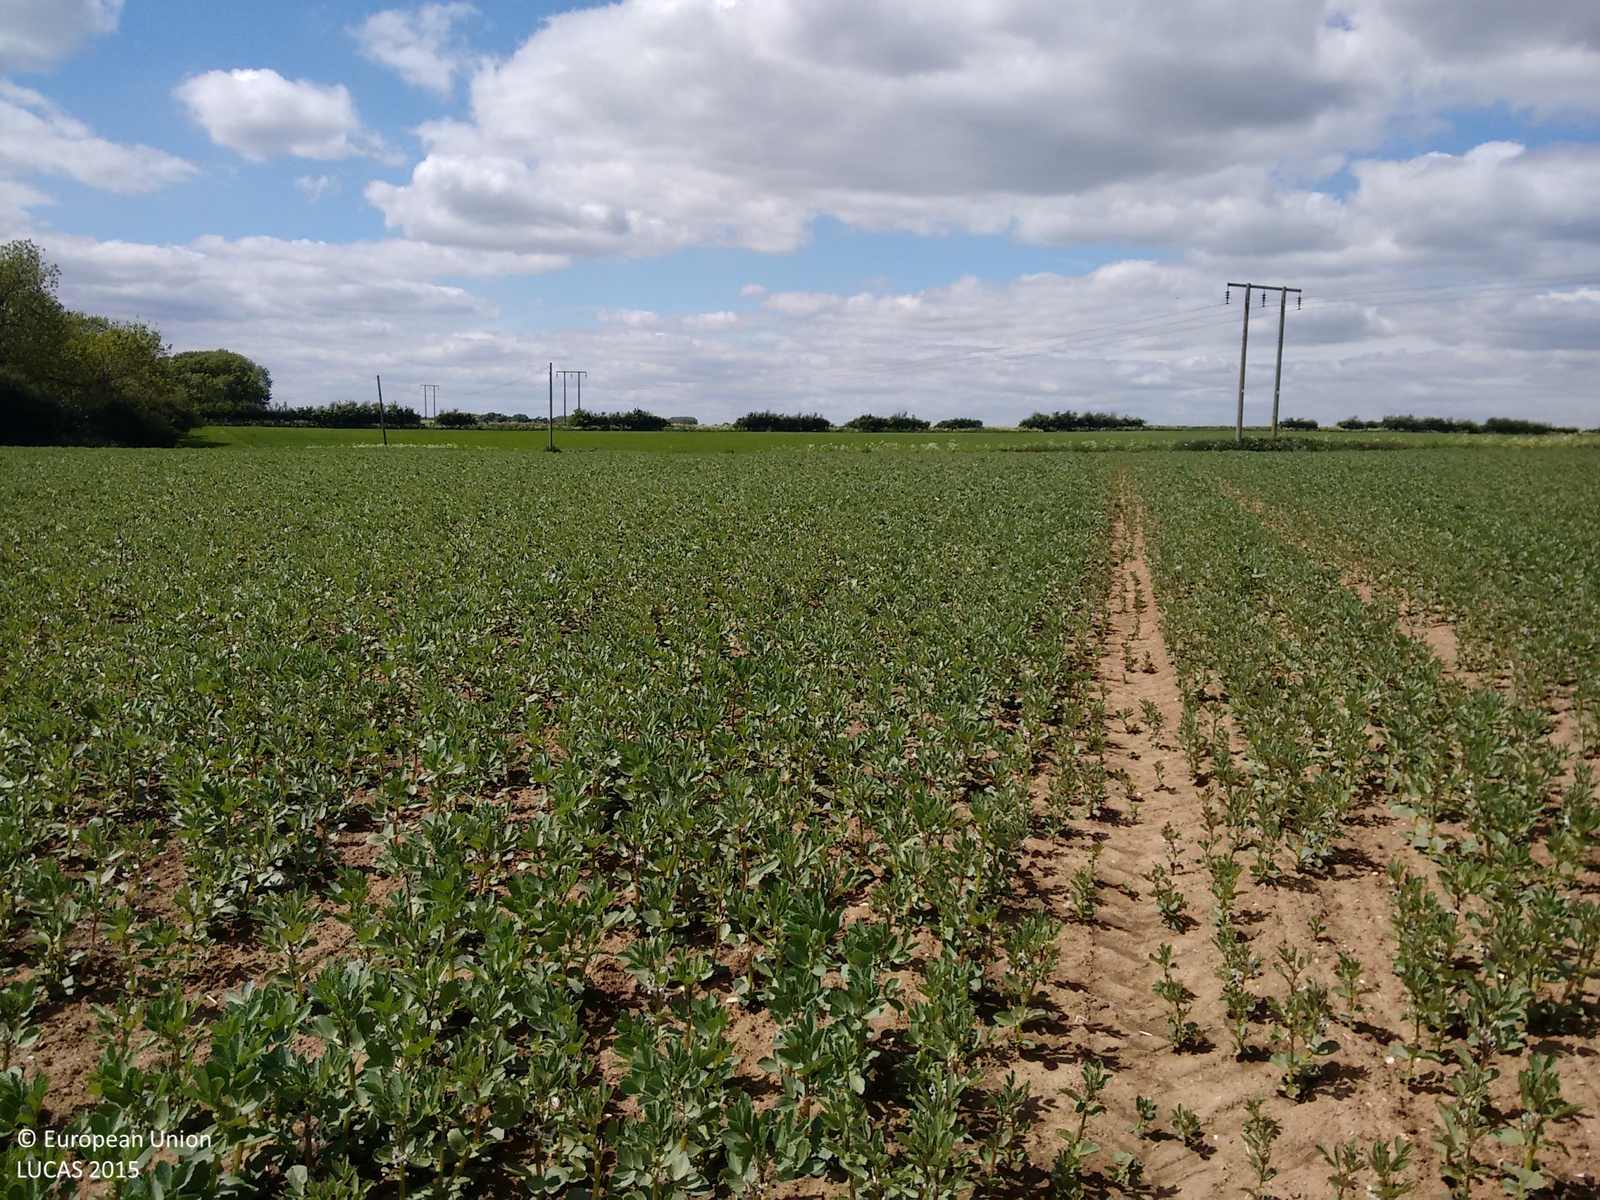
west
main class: Cropland
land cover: Dry pulses
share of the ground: 50 - 75 %
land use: Agriculture (excluding fallow land and kitchen gardens)
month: June
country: GB
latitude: 53.4823
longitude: -0.1447
